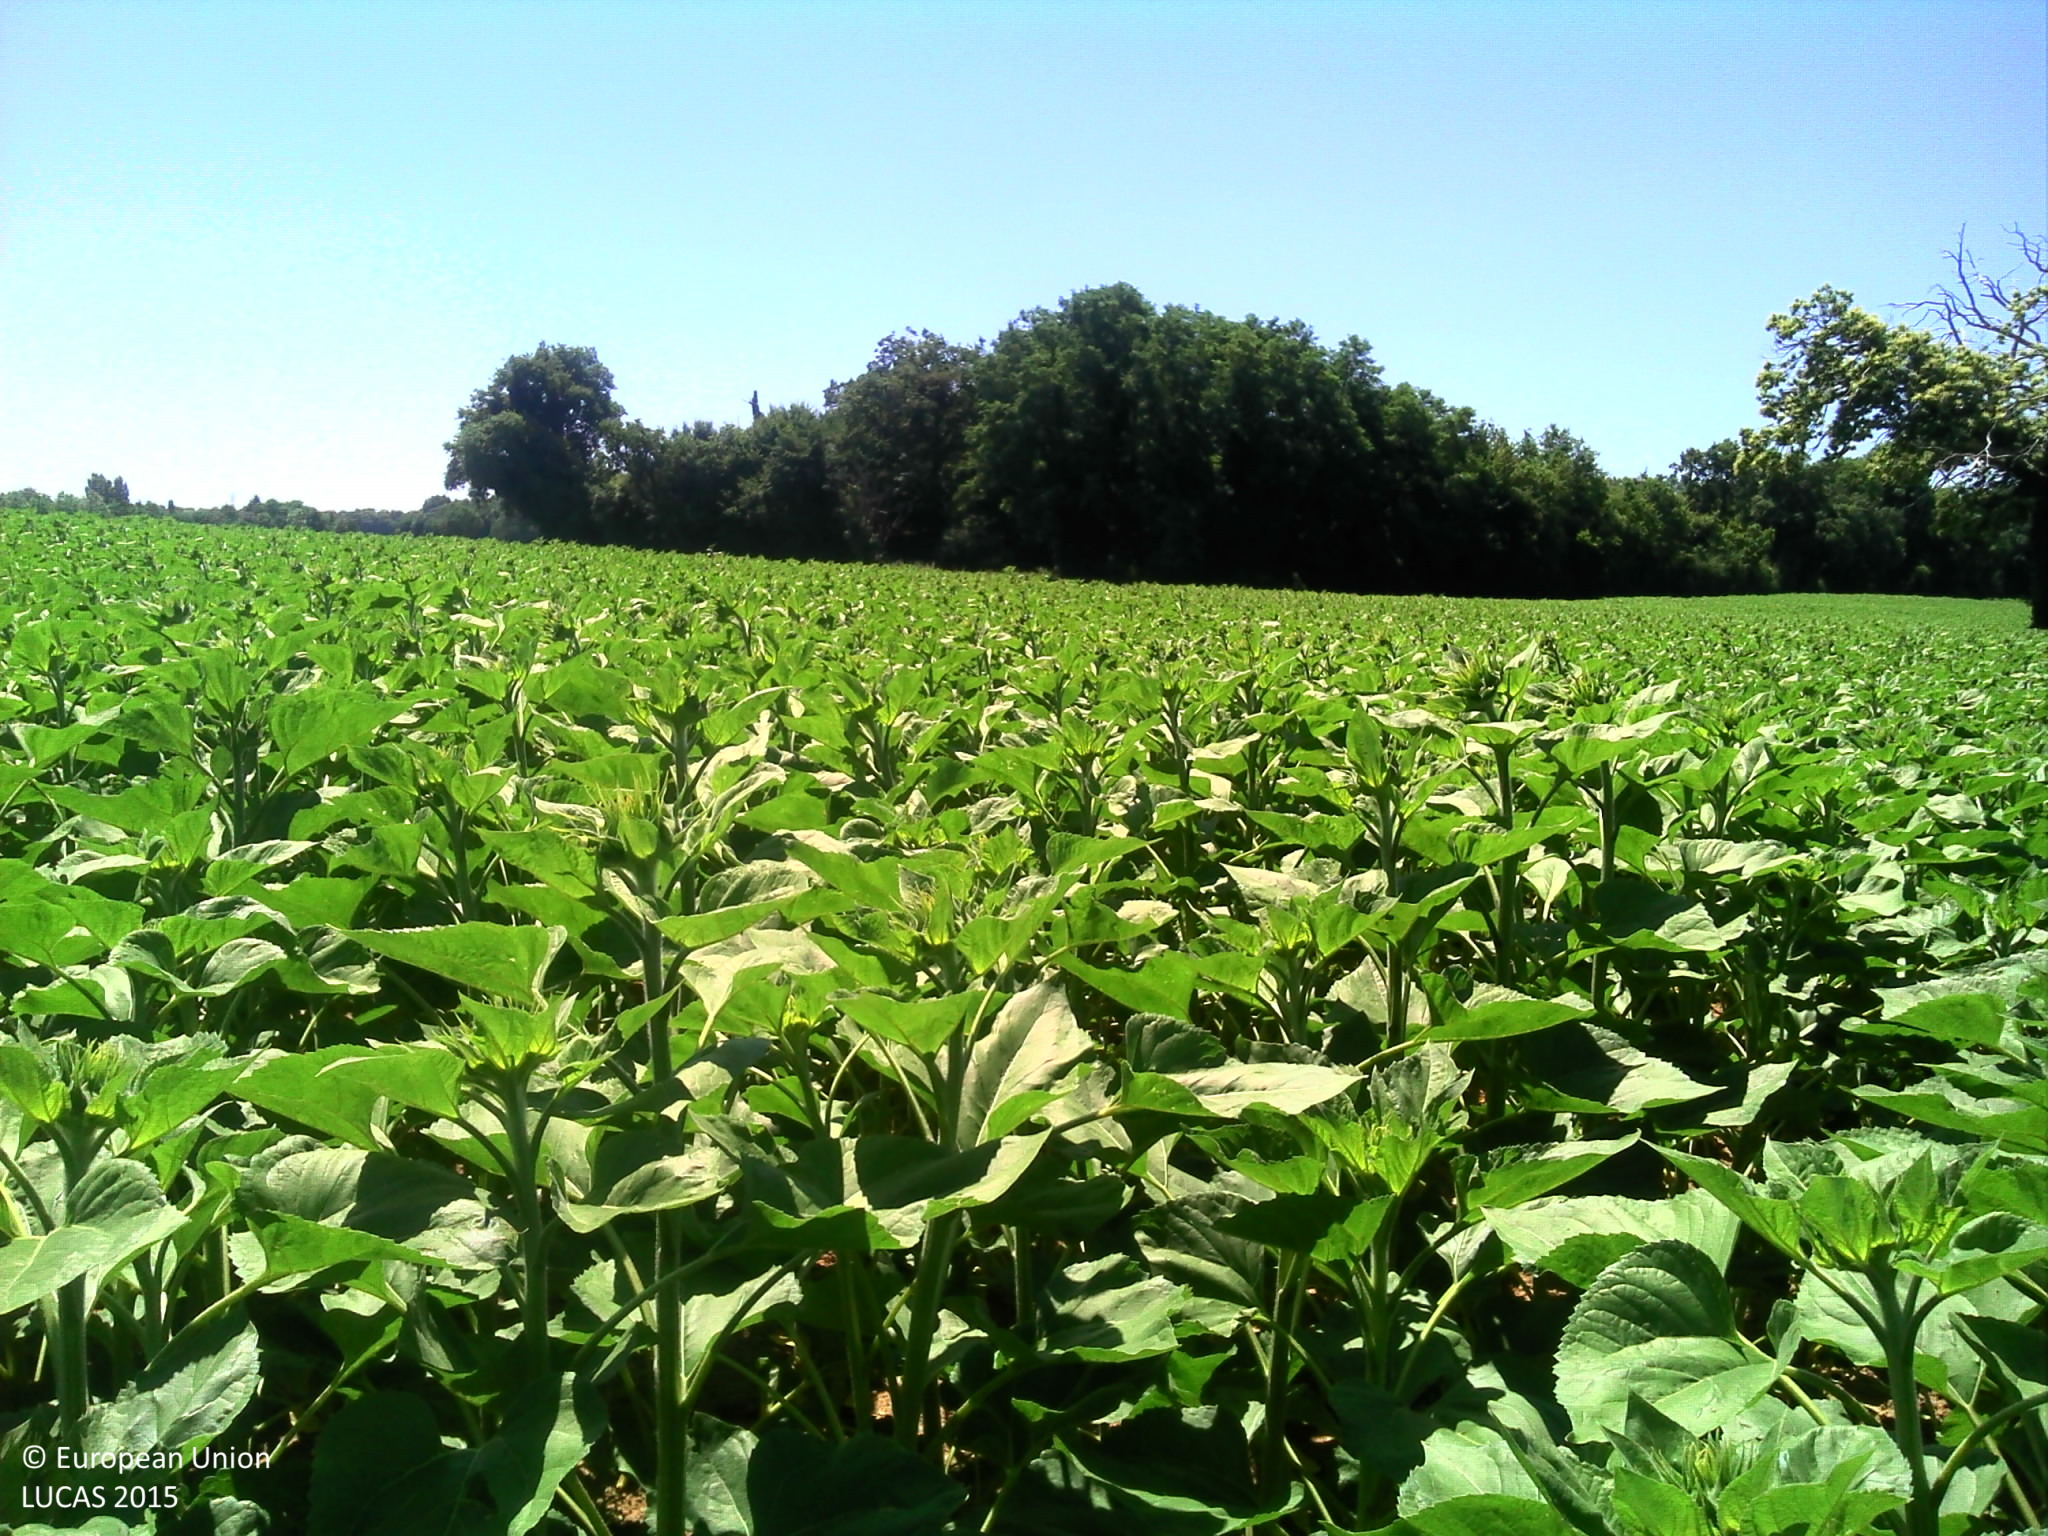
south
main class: Cropland
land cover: Sunflower
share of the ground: > 75 %
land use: Agriculture (excluding fallow land and kitchen gardens)
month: June
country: FR
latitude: 45.6507
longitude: -0.6875
